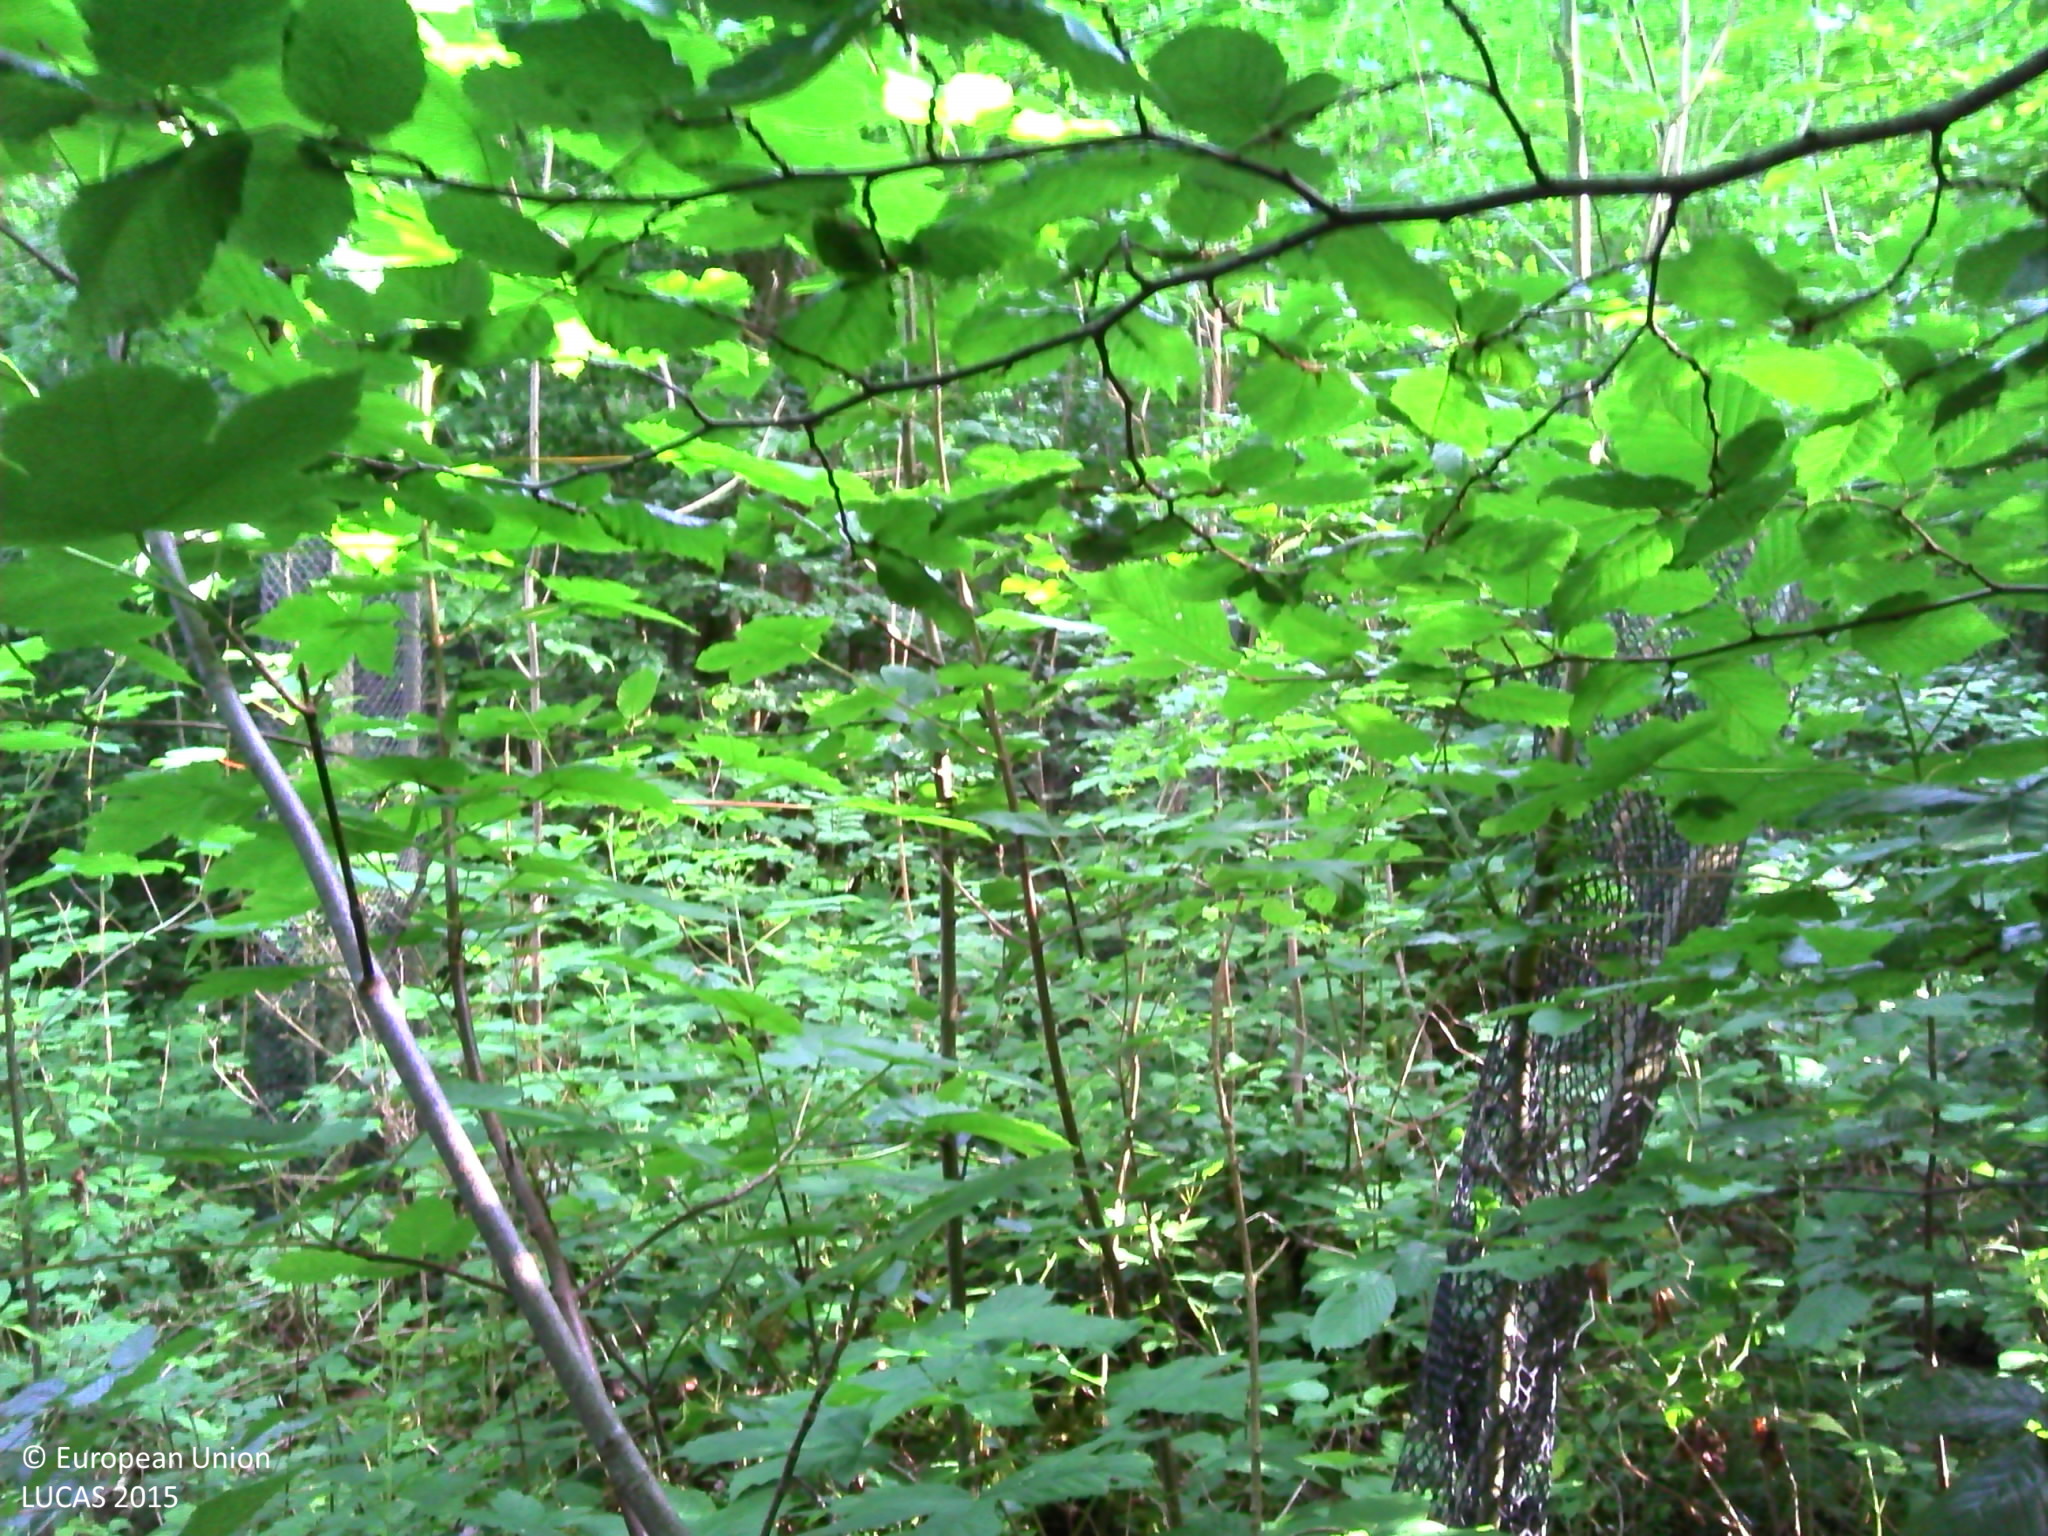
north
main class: Woodland
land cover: Broadleaved woodland
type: mesophytic deciduous forest
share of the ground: > 75 %
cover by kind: broadleaved forest trees 100 %
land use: Forestry
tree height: > 5 m
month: June
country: BE
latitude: 50.1037
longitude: 5.2582
